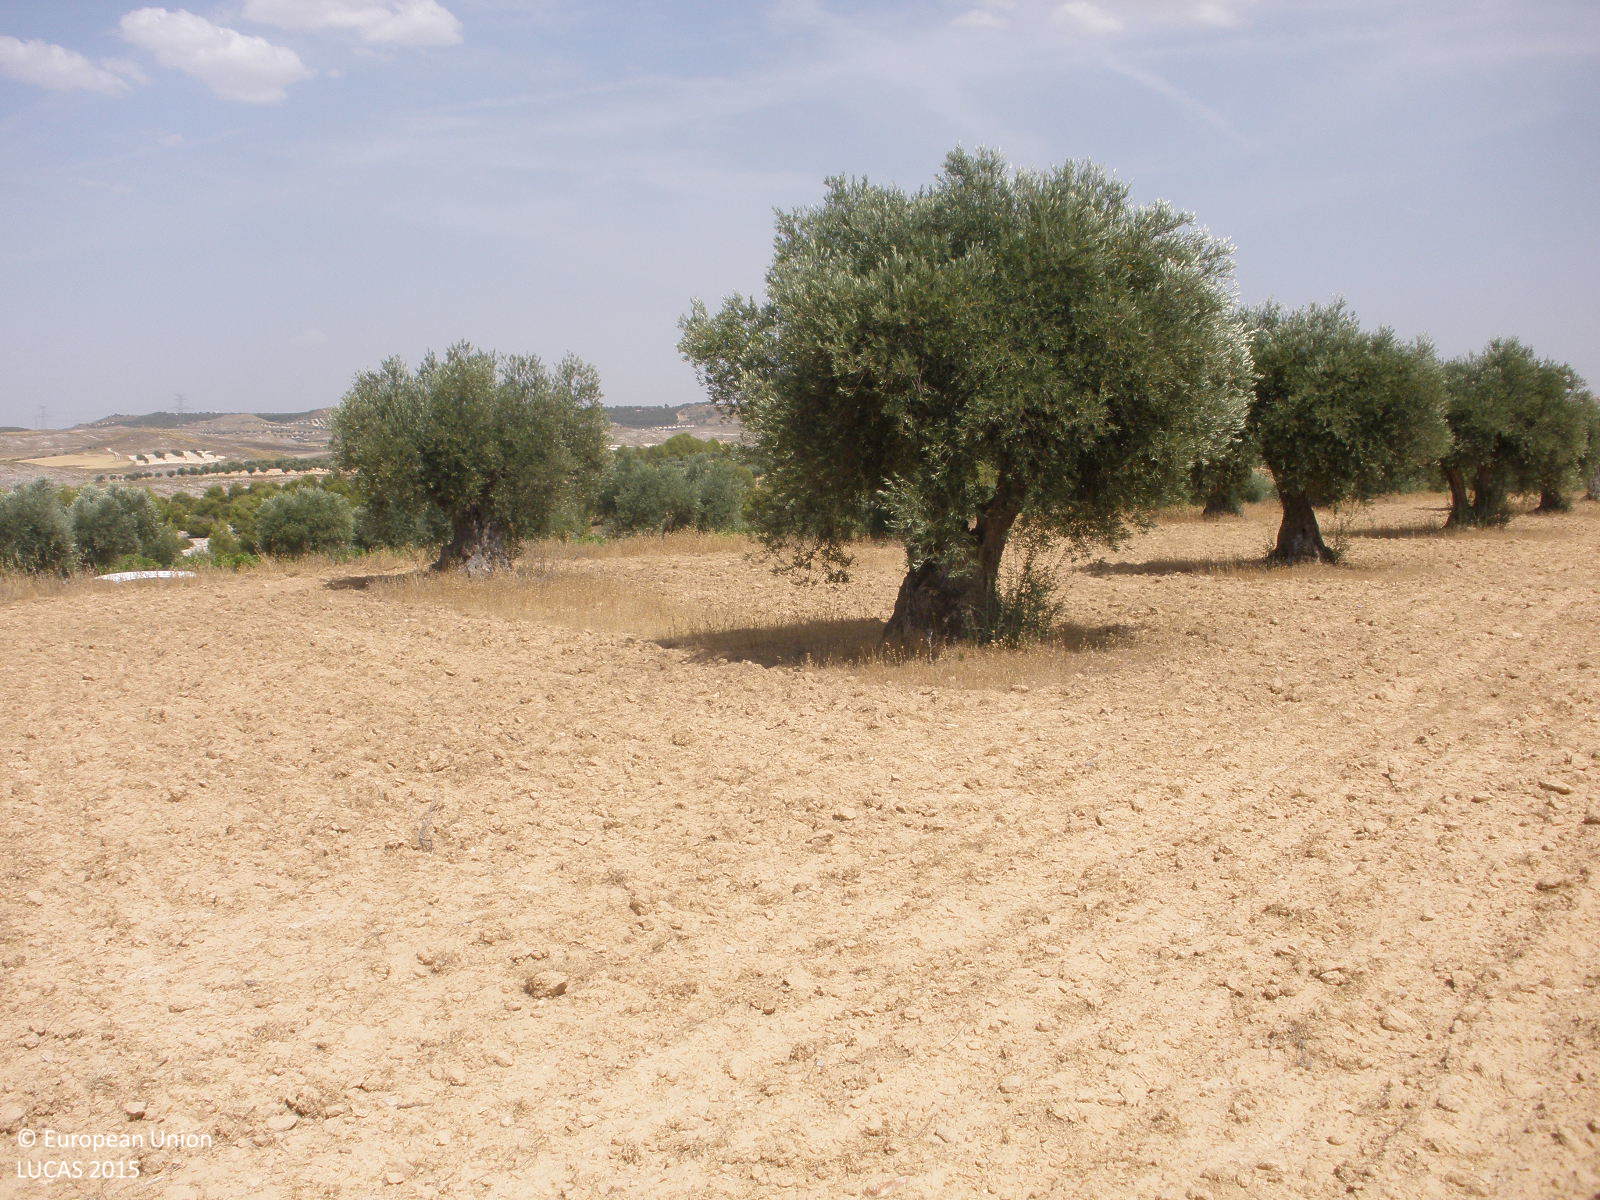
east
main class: Cropland
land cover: Olive groves
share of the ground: 25 - 50 %
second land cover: Other bare soil
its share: > 75 %
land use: Agriculture (excluding fallow land and kitchen gardens)
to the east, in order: Olive groves; Other bare soil; Grass margins; Tracks; Olive groves; Vineyards; Grass margins; Pine dominated coniferous woodland; Shrubland with sparse tree cover; Rivers and streams; Pine dominated coniferous woodland
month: July
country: ES
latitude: 40.1605
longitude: -3.4507
